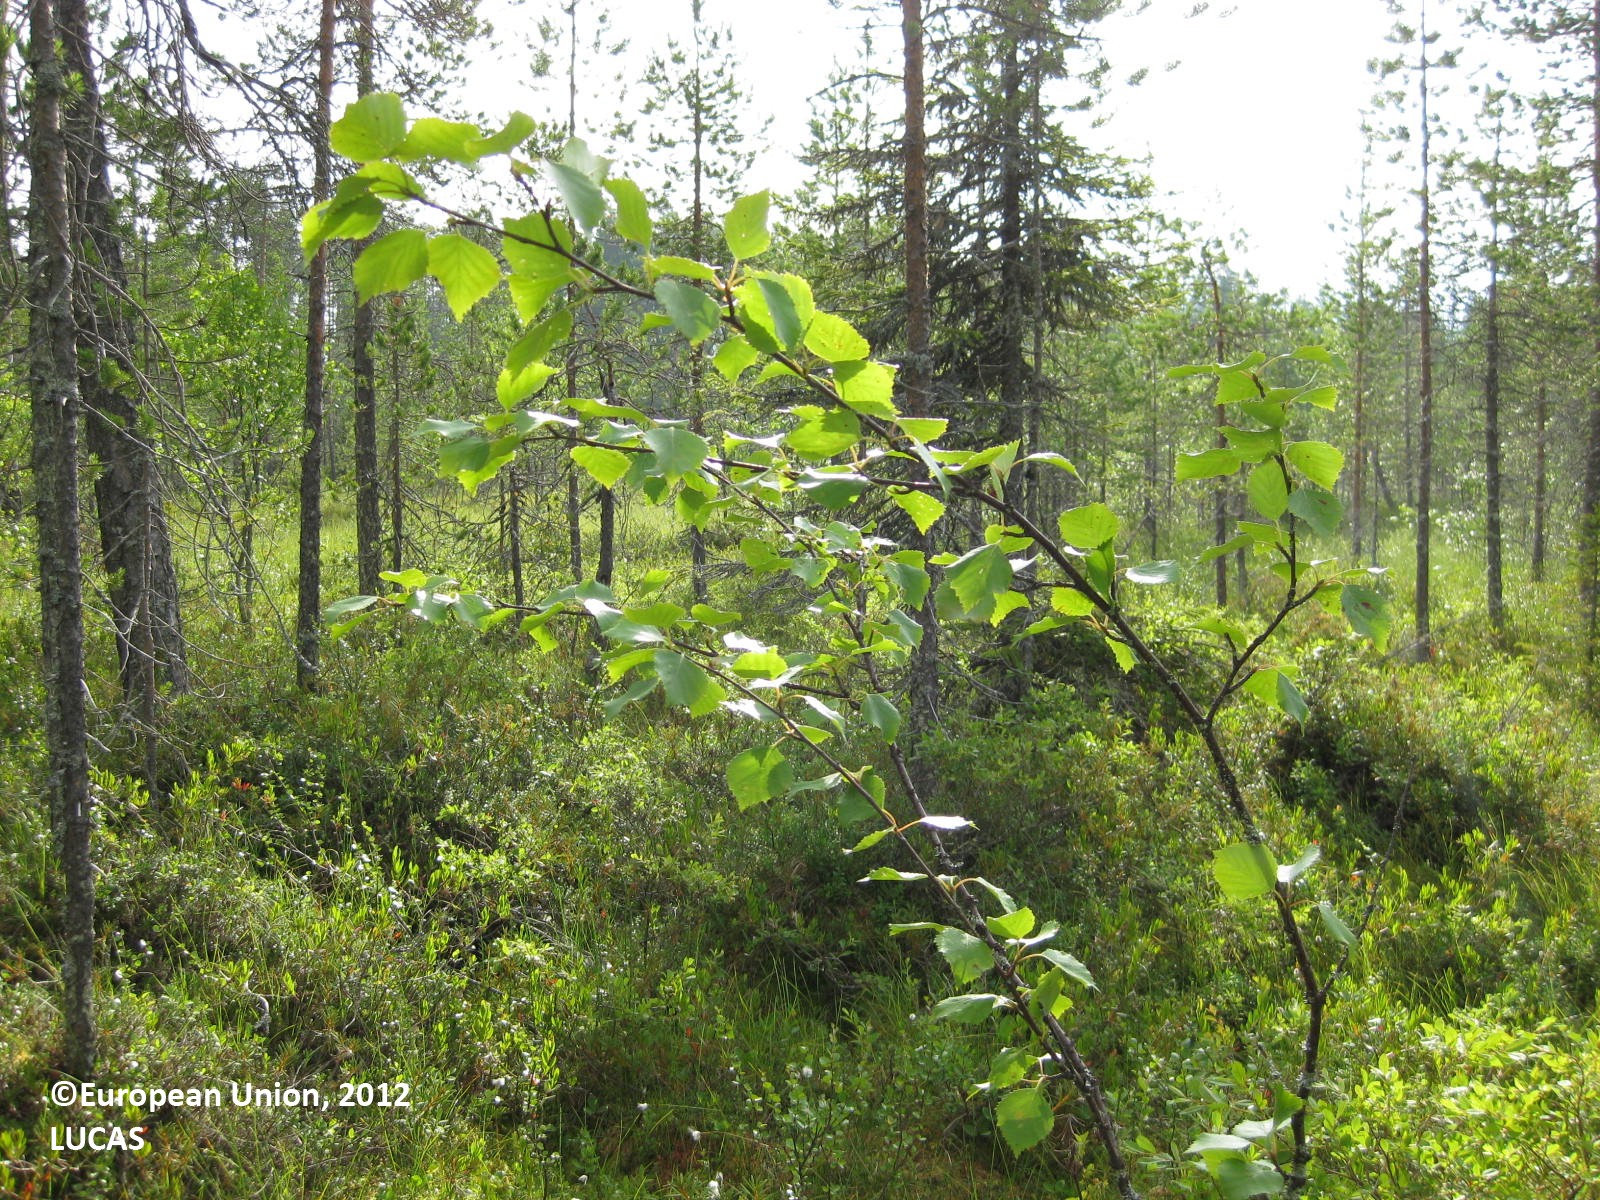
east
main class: Woodland
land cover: Pine dominated coniferous woodland
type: boreal forest
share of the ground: 50 - 75 %
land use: Forestry
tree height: > 5 m
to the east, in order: Pine dominated coniferous woodland; Ditches and canals; Abandoned hedges; Peatbogs; Pine dominated coniferous woodland; Ditches and canals; Pine dominated coniferous woodland; Pine dominated mixed woodland; Other coniferous woodland
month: July
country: FI
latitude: 65.7679
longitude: 28.6120
